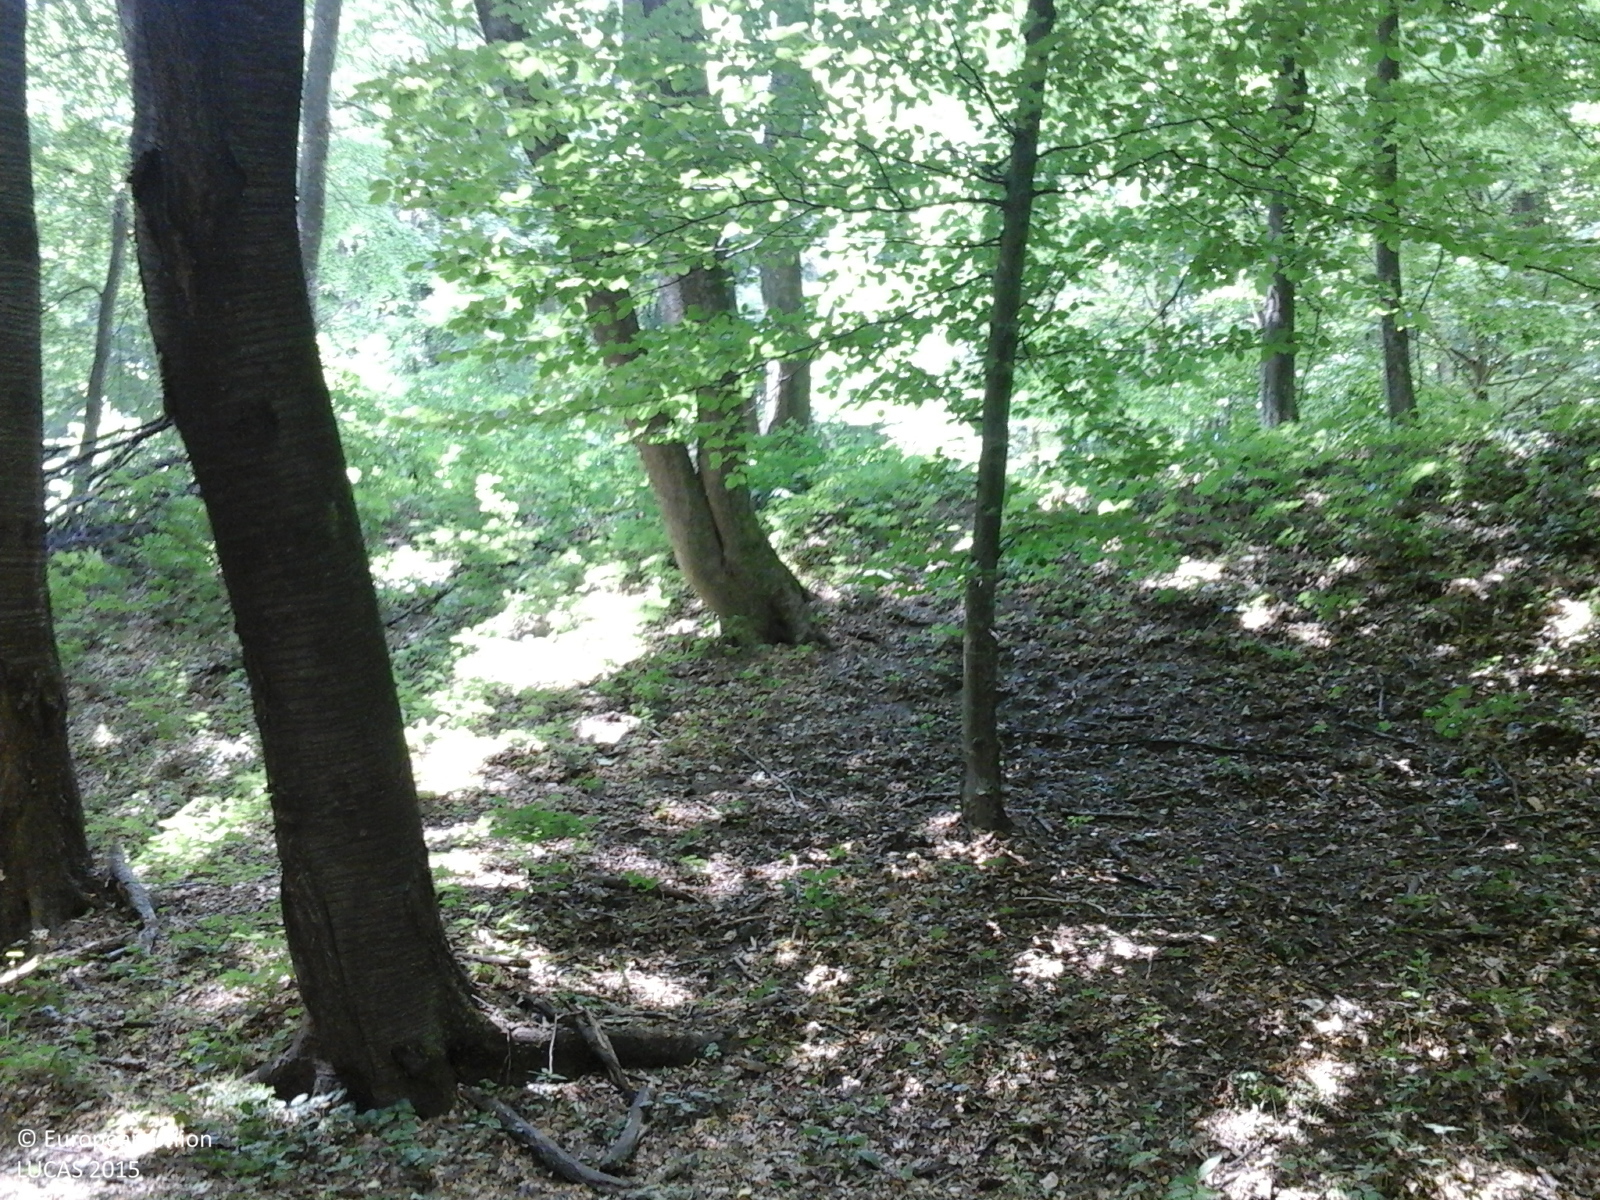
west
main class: Woodland
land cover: Broadleaved woodland
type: beech forest
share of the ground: > 75 %
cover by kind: broadleaved forest trees 100 %
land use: Forestry
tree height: > 5 m
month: June
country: RO
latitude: 46.9055
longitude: 26.6703
